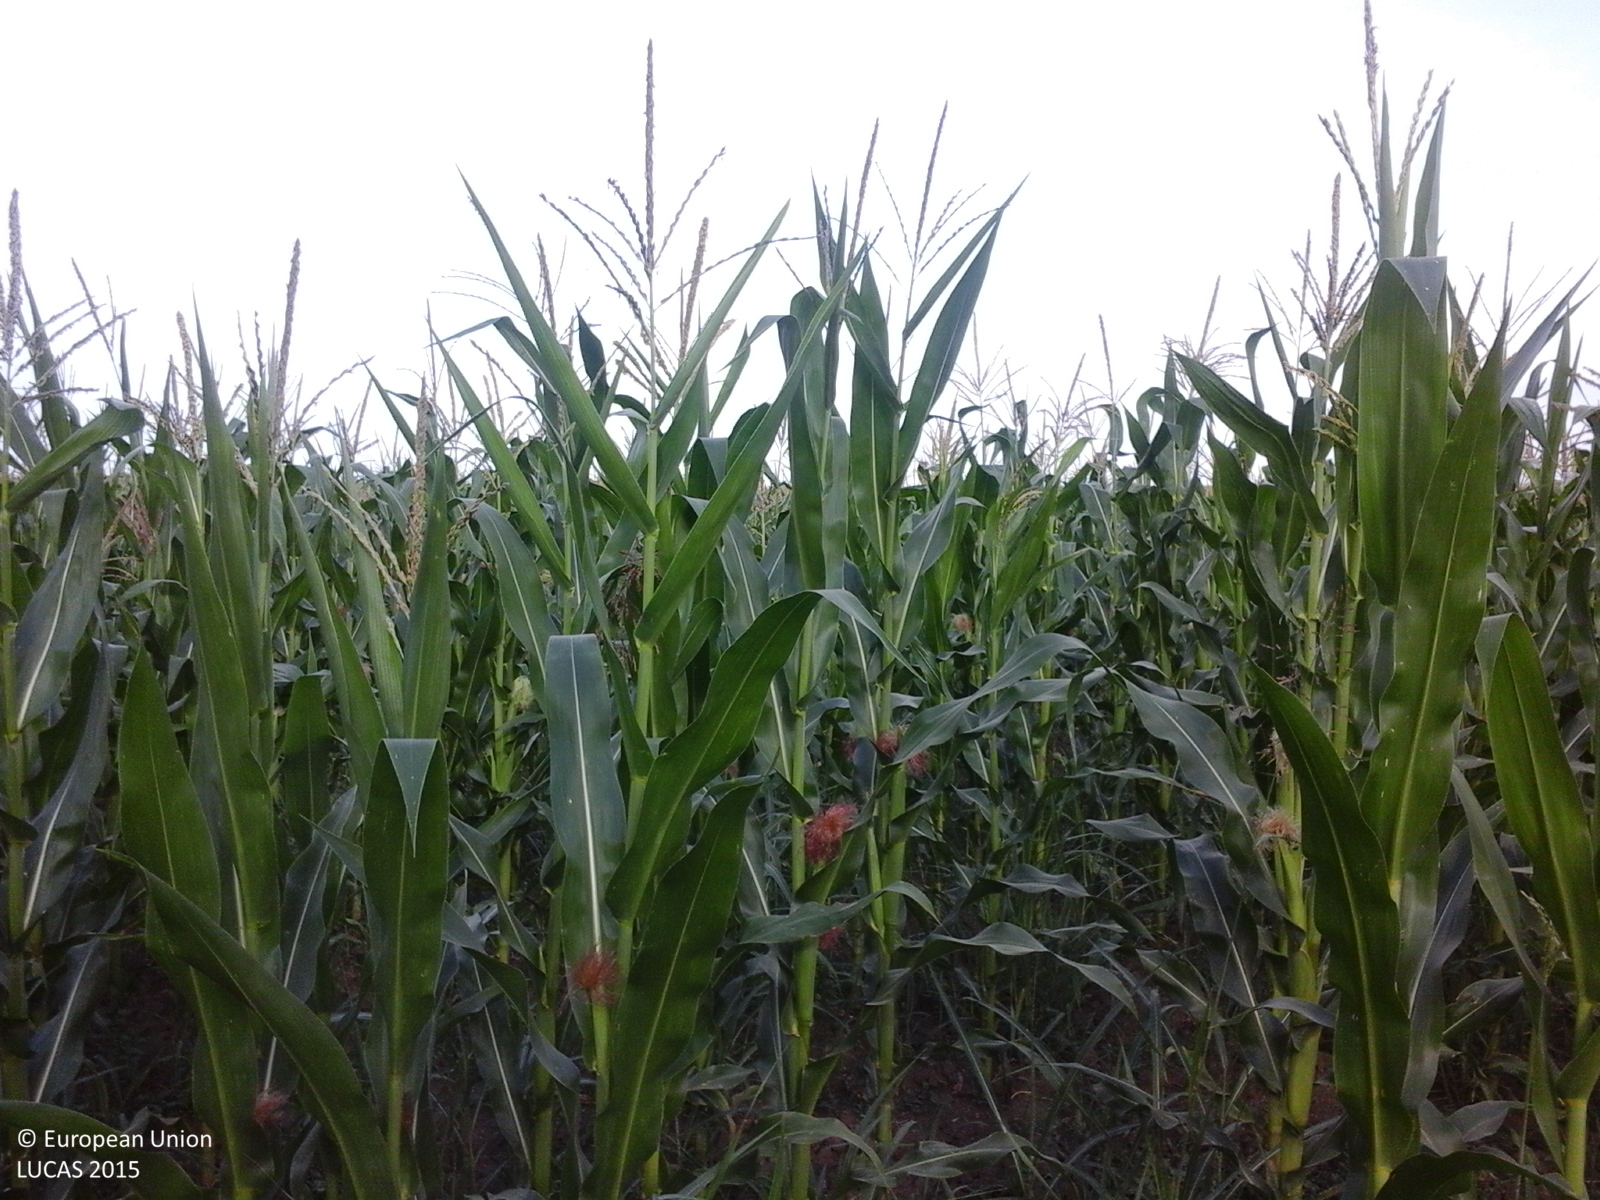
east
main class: Cropland
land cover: Maize
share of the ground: > 75 %
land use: Agriculture (excluding fallow land and kitchen gardens)
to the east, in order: Maize; Sunflower; Maize; Grass margins; Single bushes/trees
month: July
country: RO
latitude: 43.7660
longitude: 24.2331
